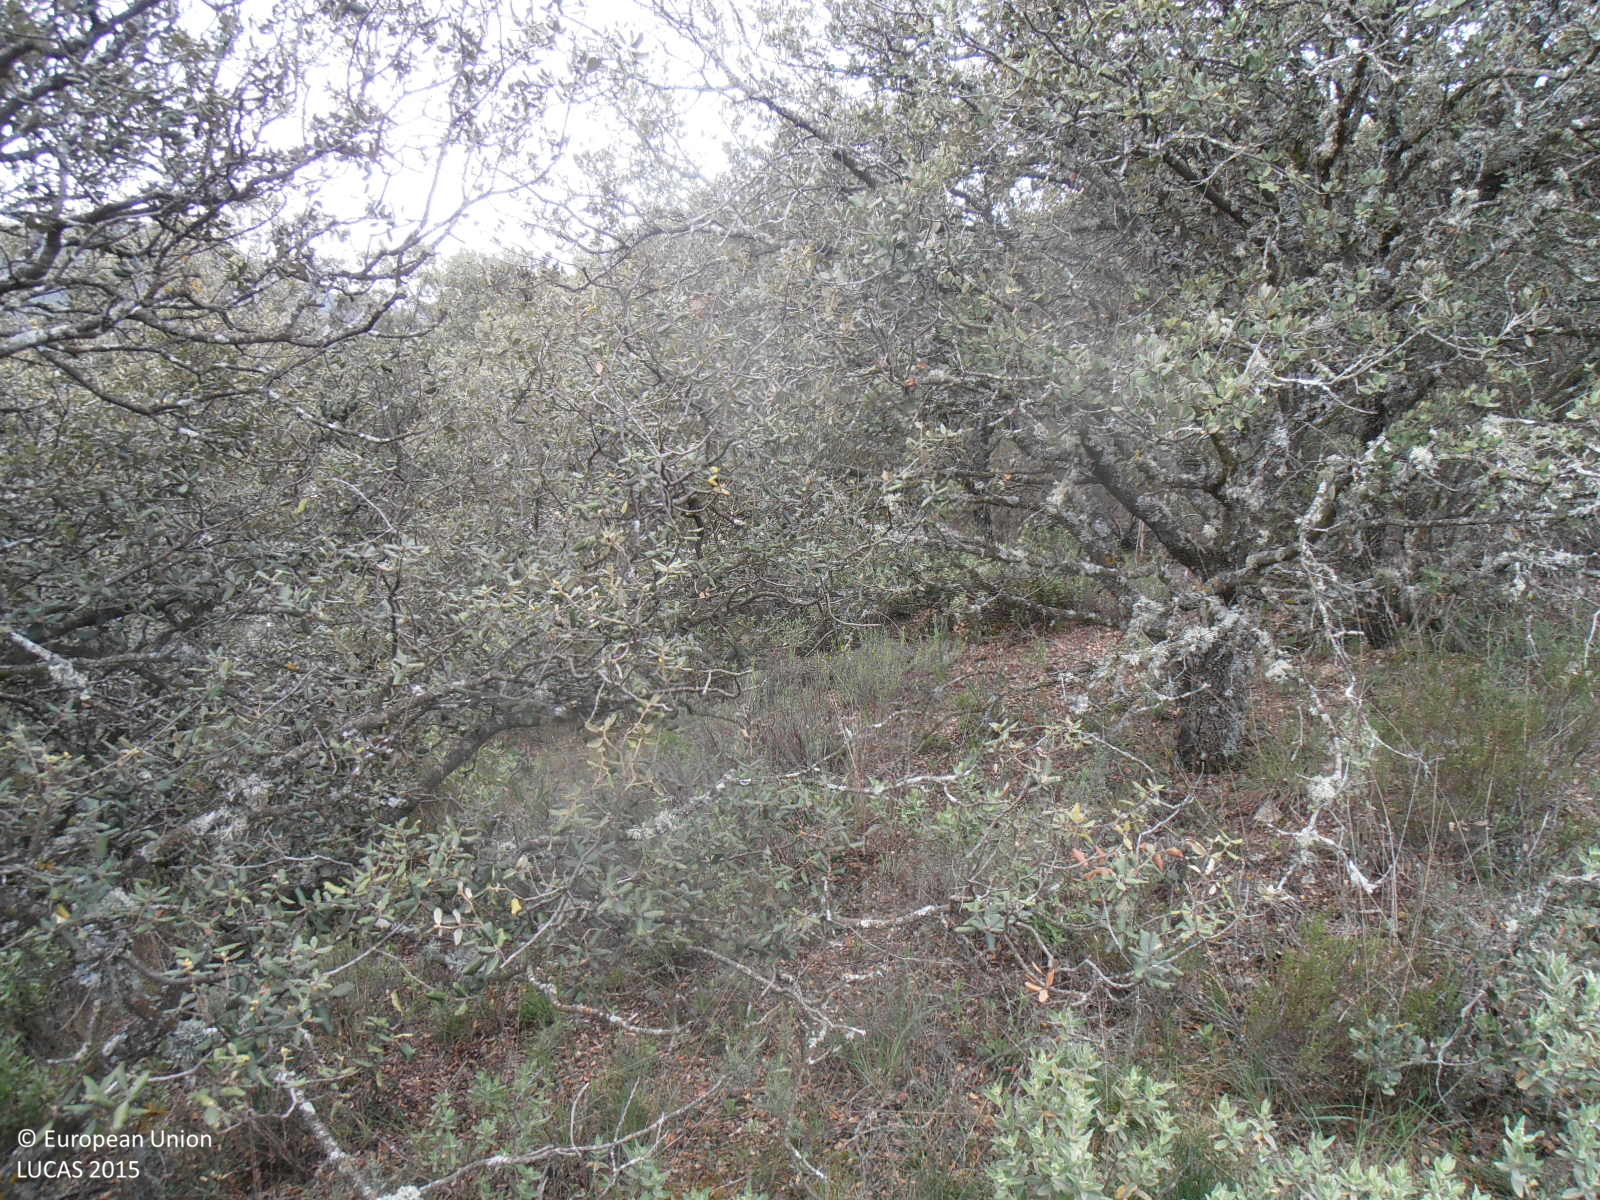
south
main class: Woodland
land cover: Broadleaved woodland
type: thermophilous deciduous forest
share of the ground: > 75 %
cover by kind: broadleaved forest trees 80 %, shrubs 20 %
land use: Semi-natural and natural areas not in use
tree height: < 5 m
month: April
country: ES
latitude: 41.2015
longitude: -1.1214
